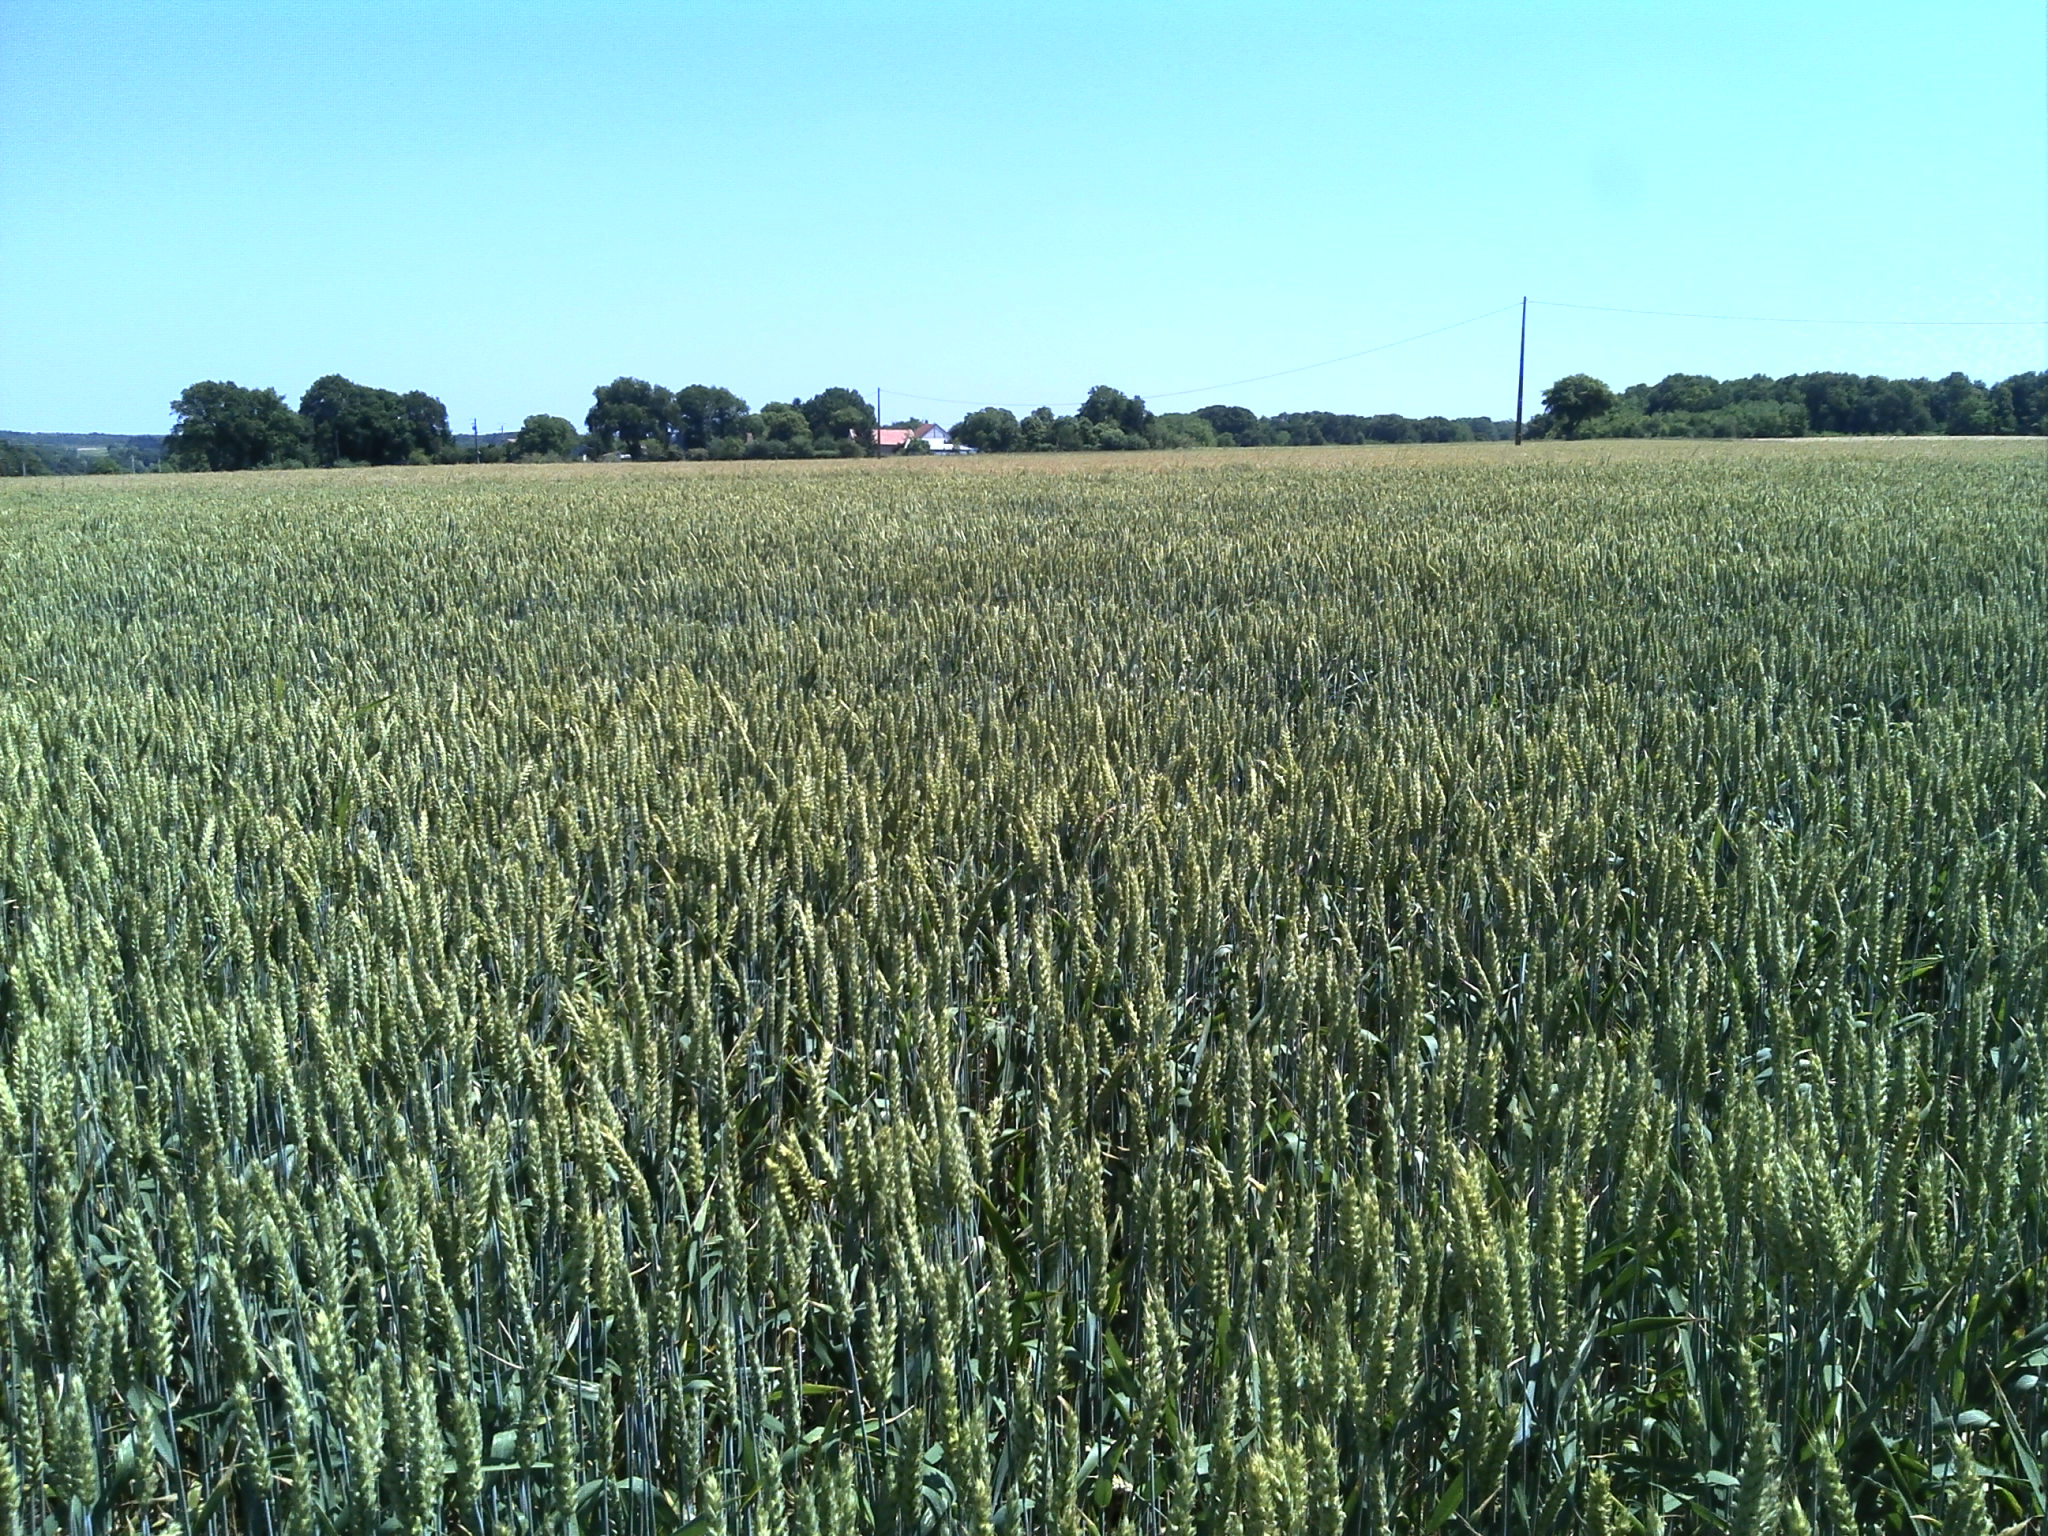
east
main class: Cropland
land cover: Common wheat
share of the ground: > 75 %
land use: Agriculture (excluding fallow land and kitchen gardens)
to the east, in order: Common wheat; Electric lines; Common wheat
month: June
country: FR
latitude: 47.1651
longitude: 1.4254
